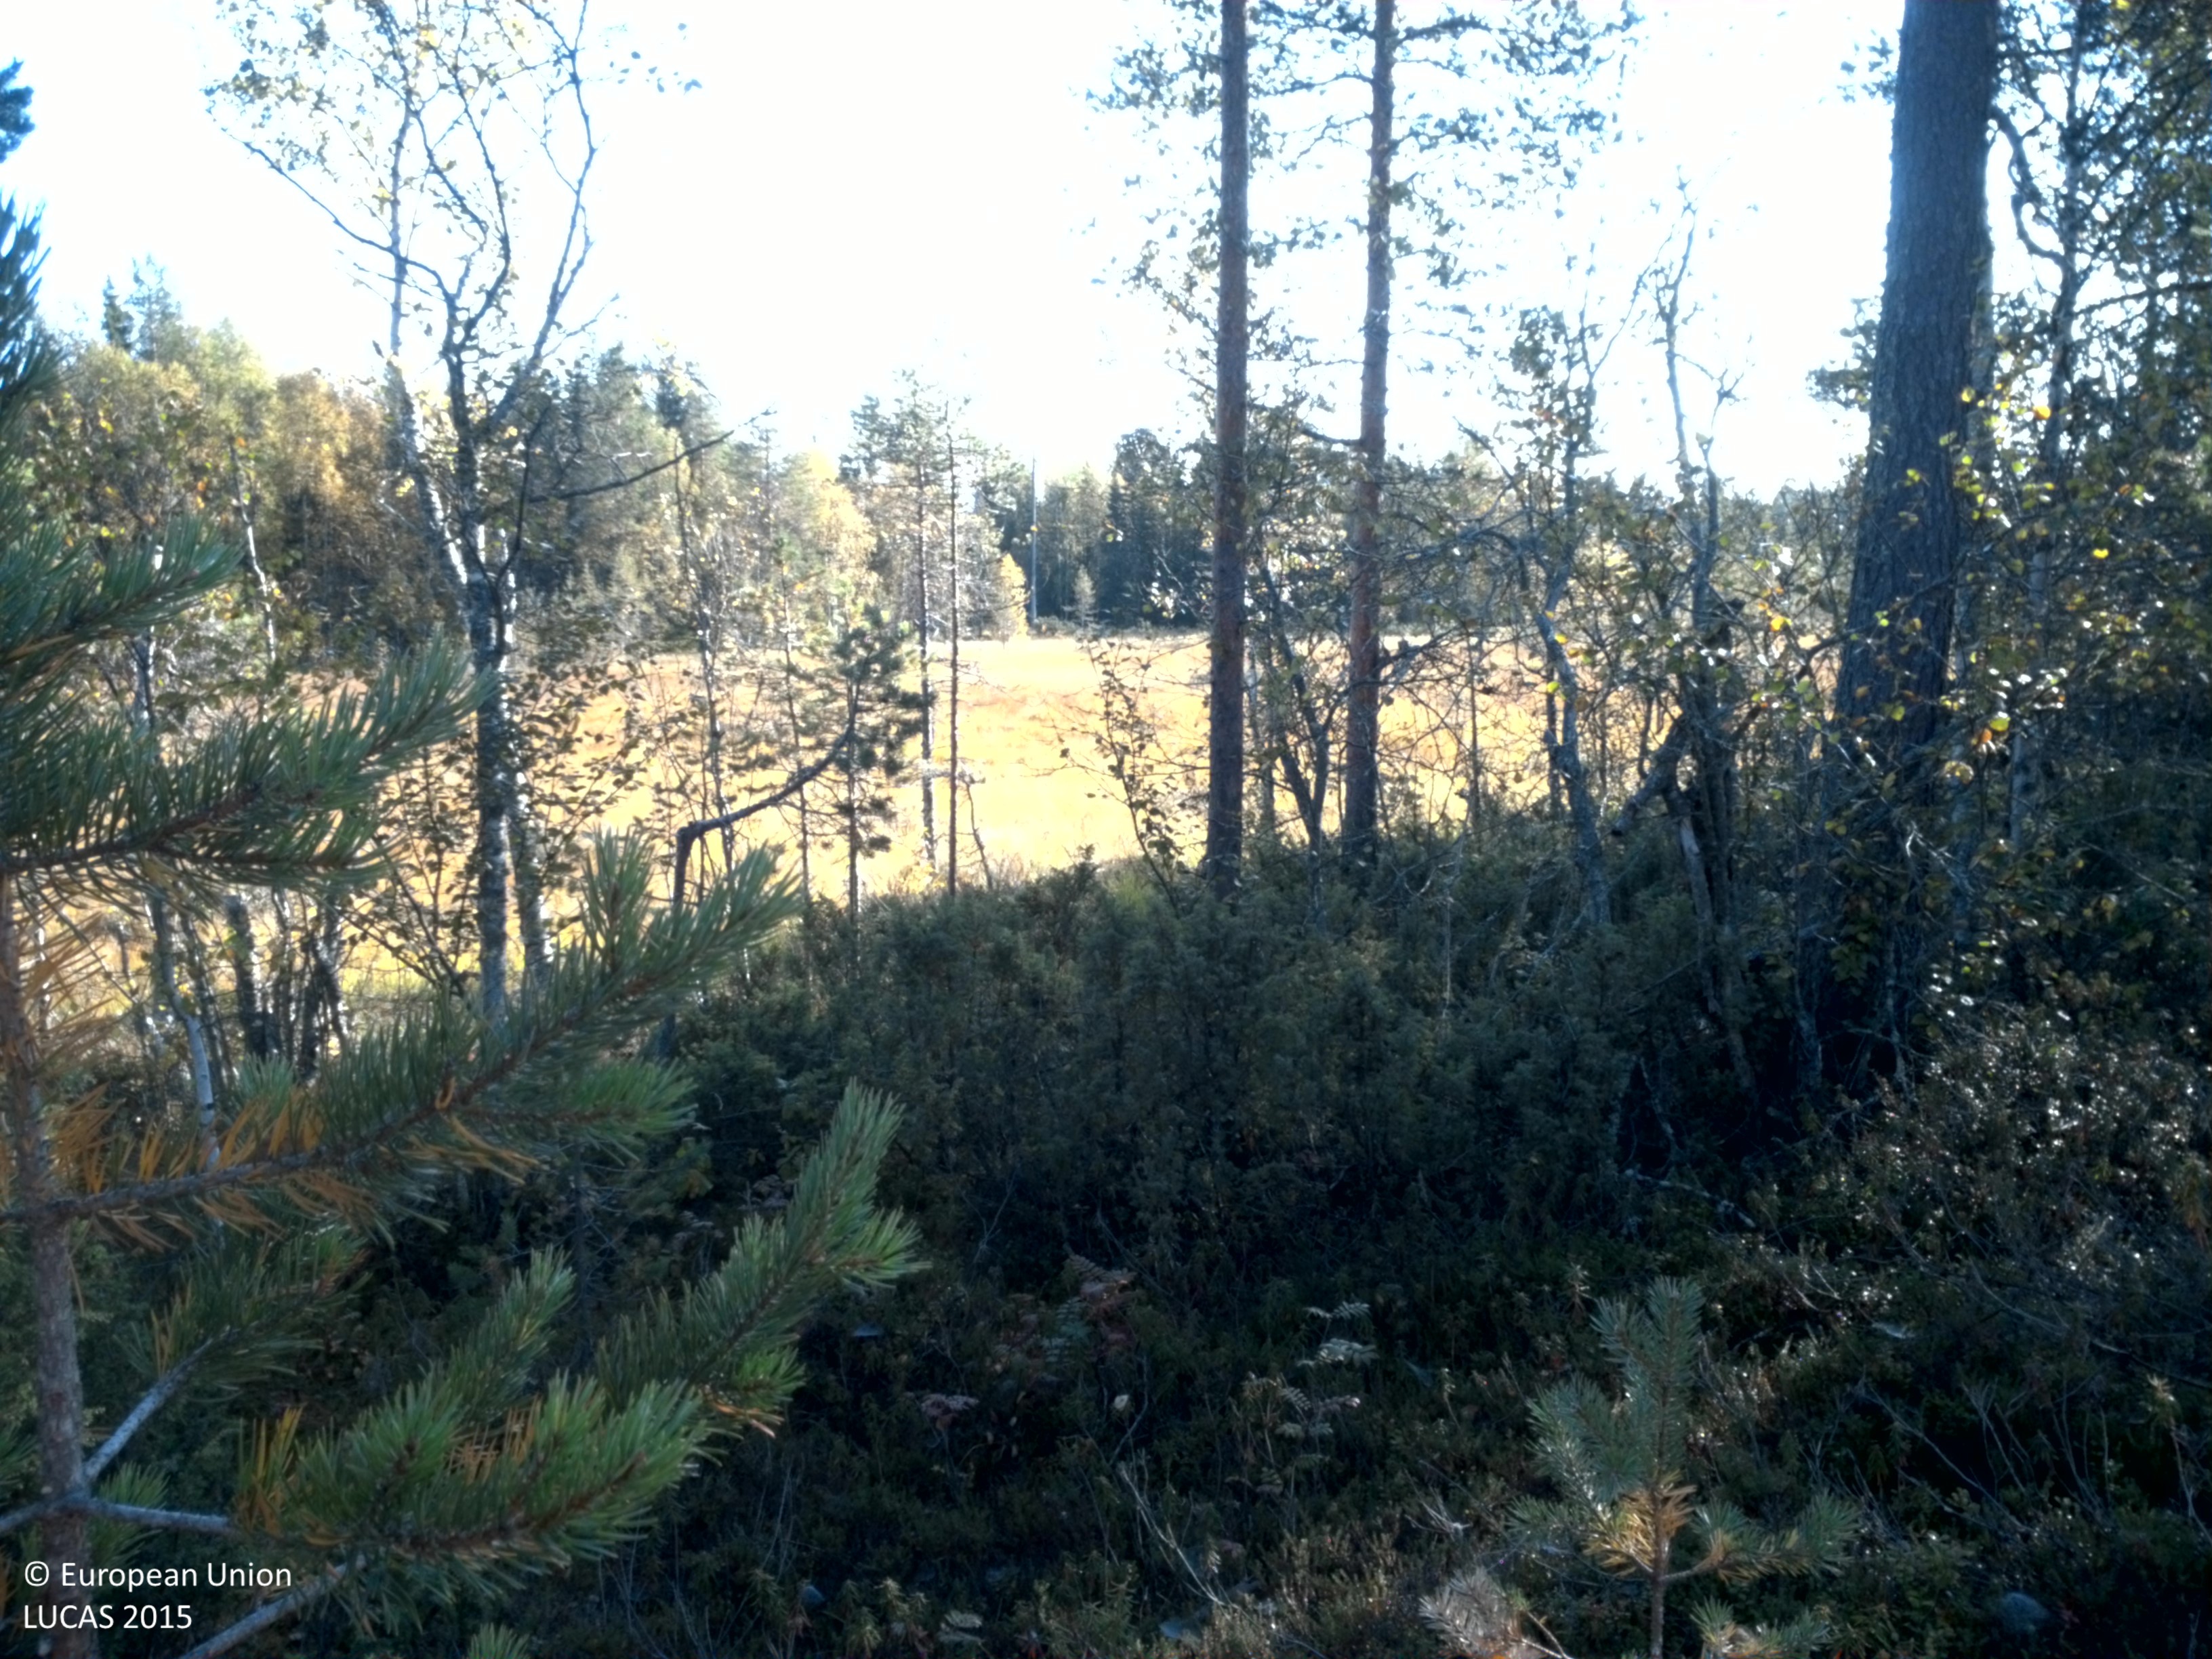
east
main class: Woodland
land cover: Pine dominated mixed woodland
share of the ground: 25 - 50 %
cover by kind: shrubs 60 %, coniferous forest trees 20 %, broadleaved forest trees 20 %
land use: Forestry
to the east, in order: Pine dominated mixed woodland; Peatbogs; Shrubland with sparse tree cover; Electric lines; Shrubland with sparse tree cover; Spruce dominated coniferous woodland; Pine dominated coniferous woodland
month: September
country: SE
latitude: 65.8976
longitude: 22.5548
